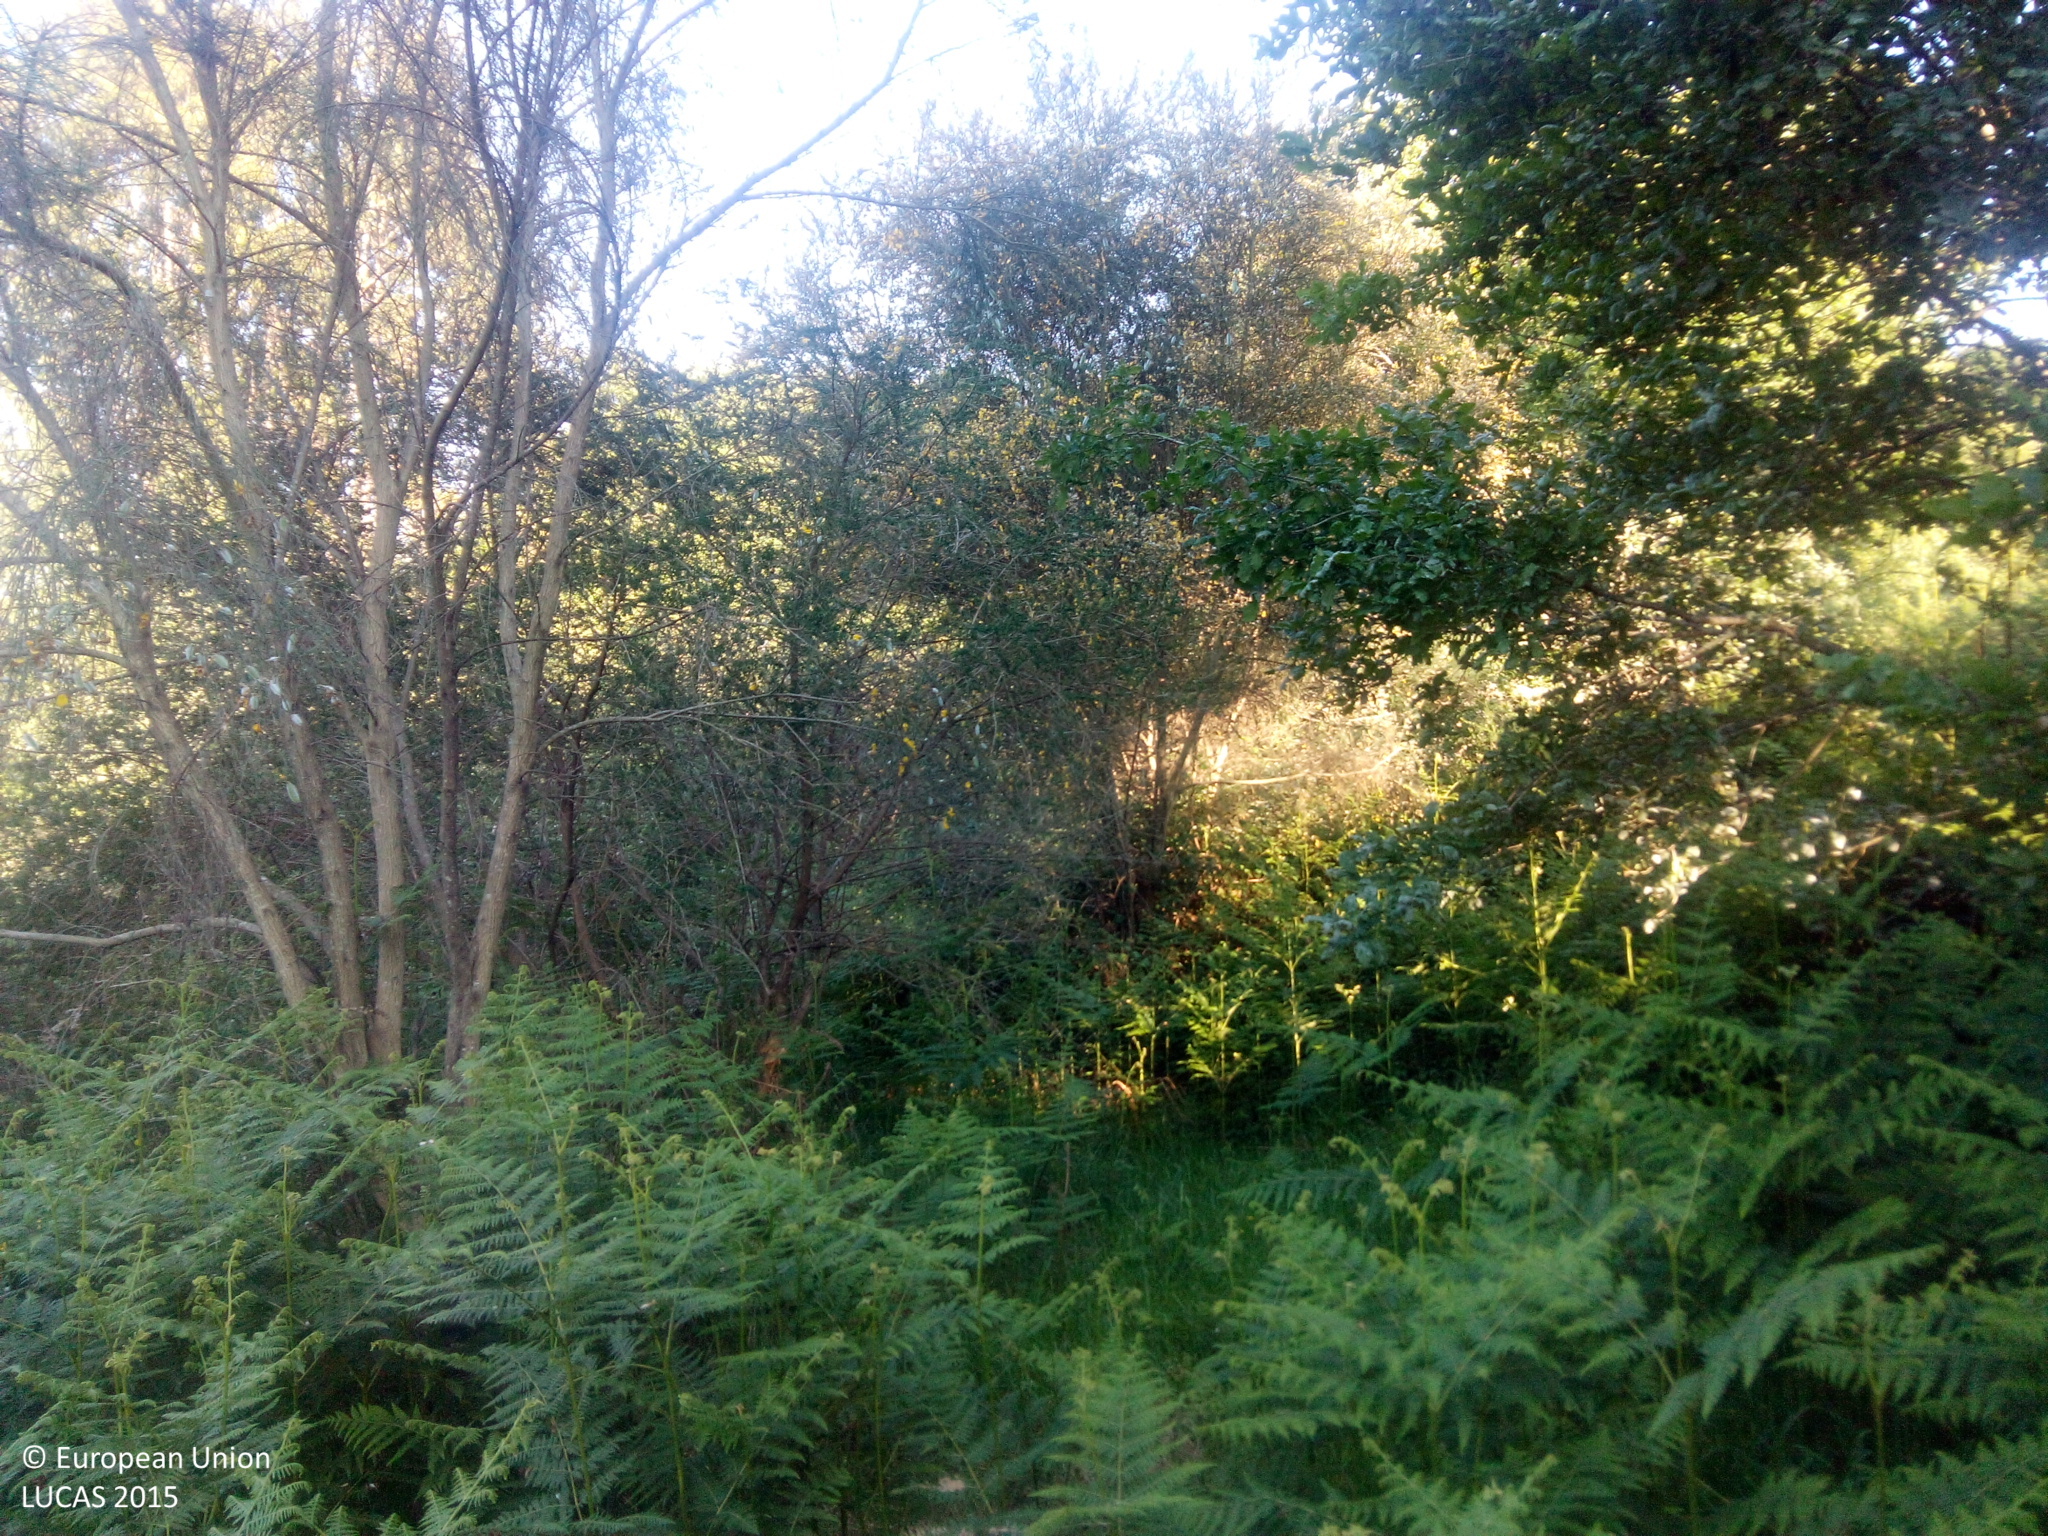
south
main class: Grassland
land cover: Grassland with sparse tree/shrub cover
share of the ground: > 75 %
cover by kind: herbaceous plants 95 %, broadleaved forest trees 5 %
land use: Agriculture (excluding fallow land and kitchen gardens)
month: June
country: ES
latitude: 42.2436
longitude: -8.3036
